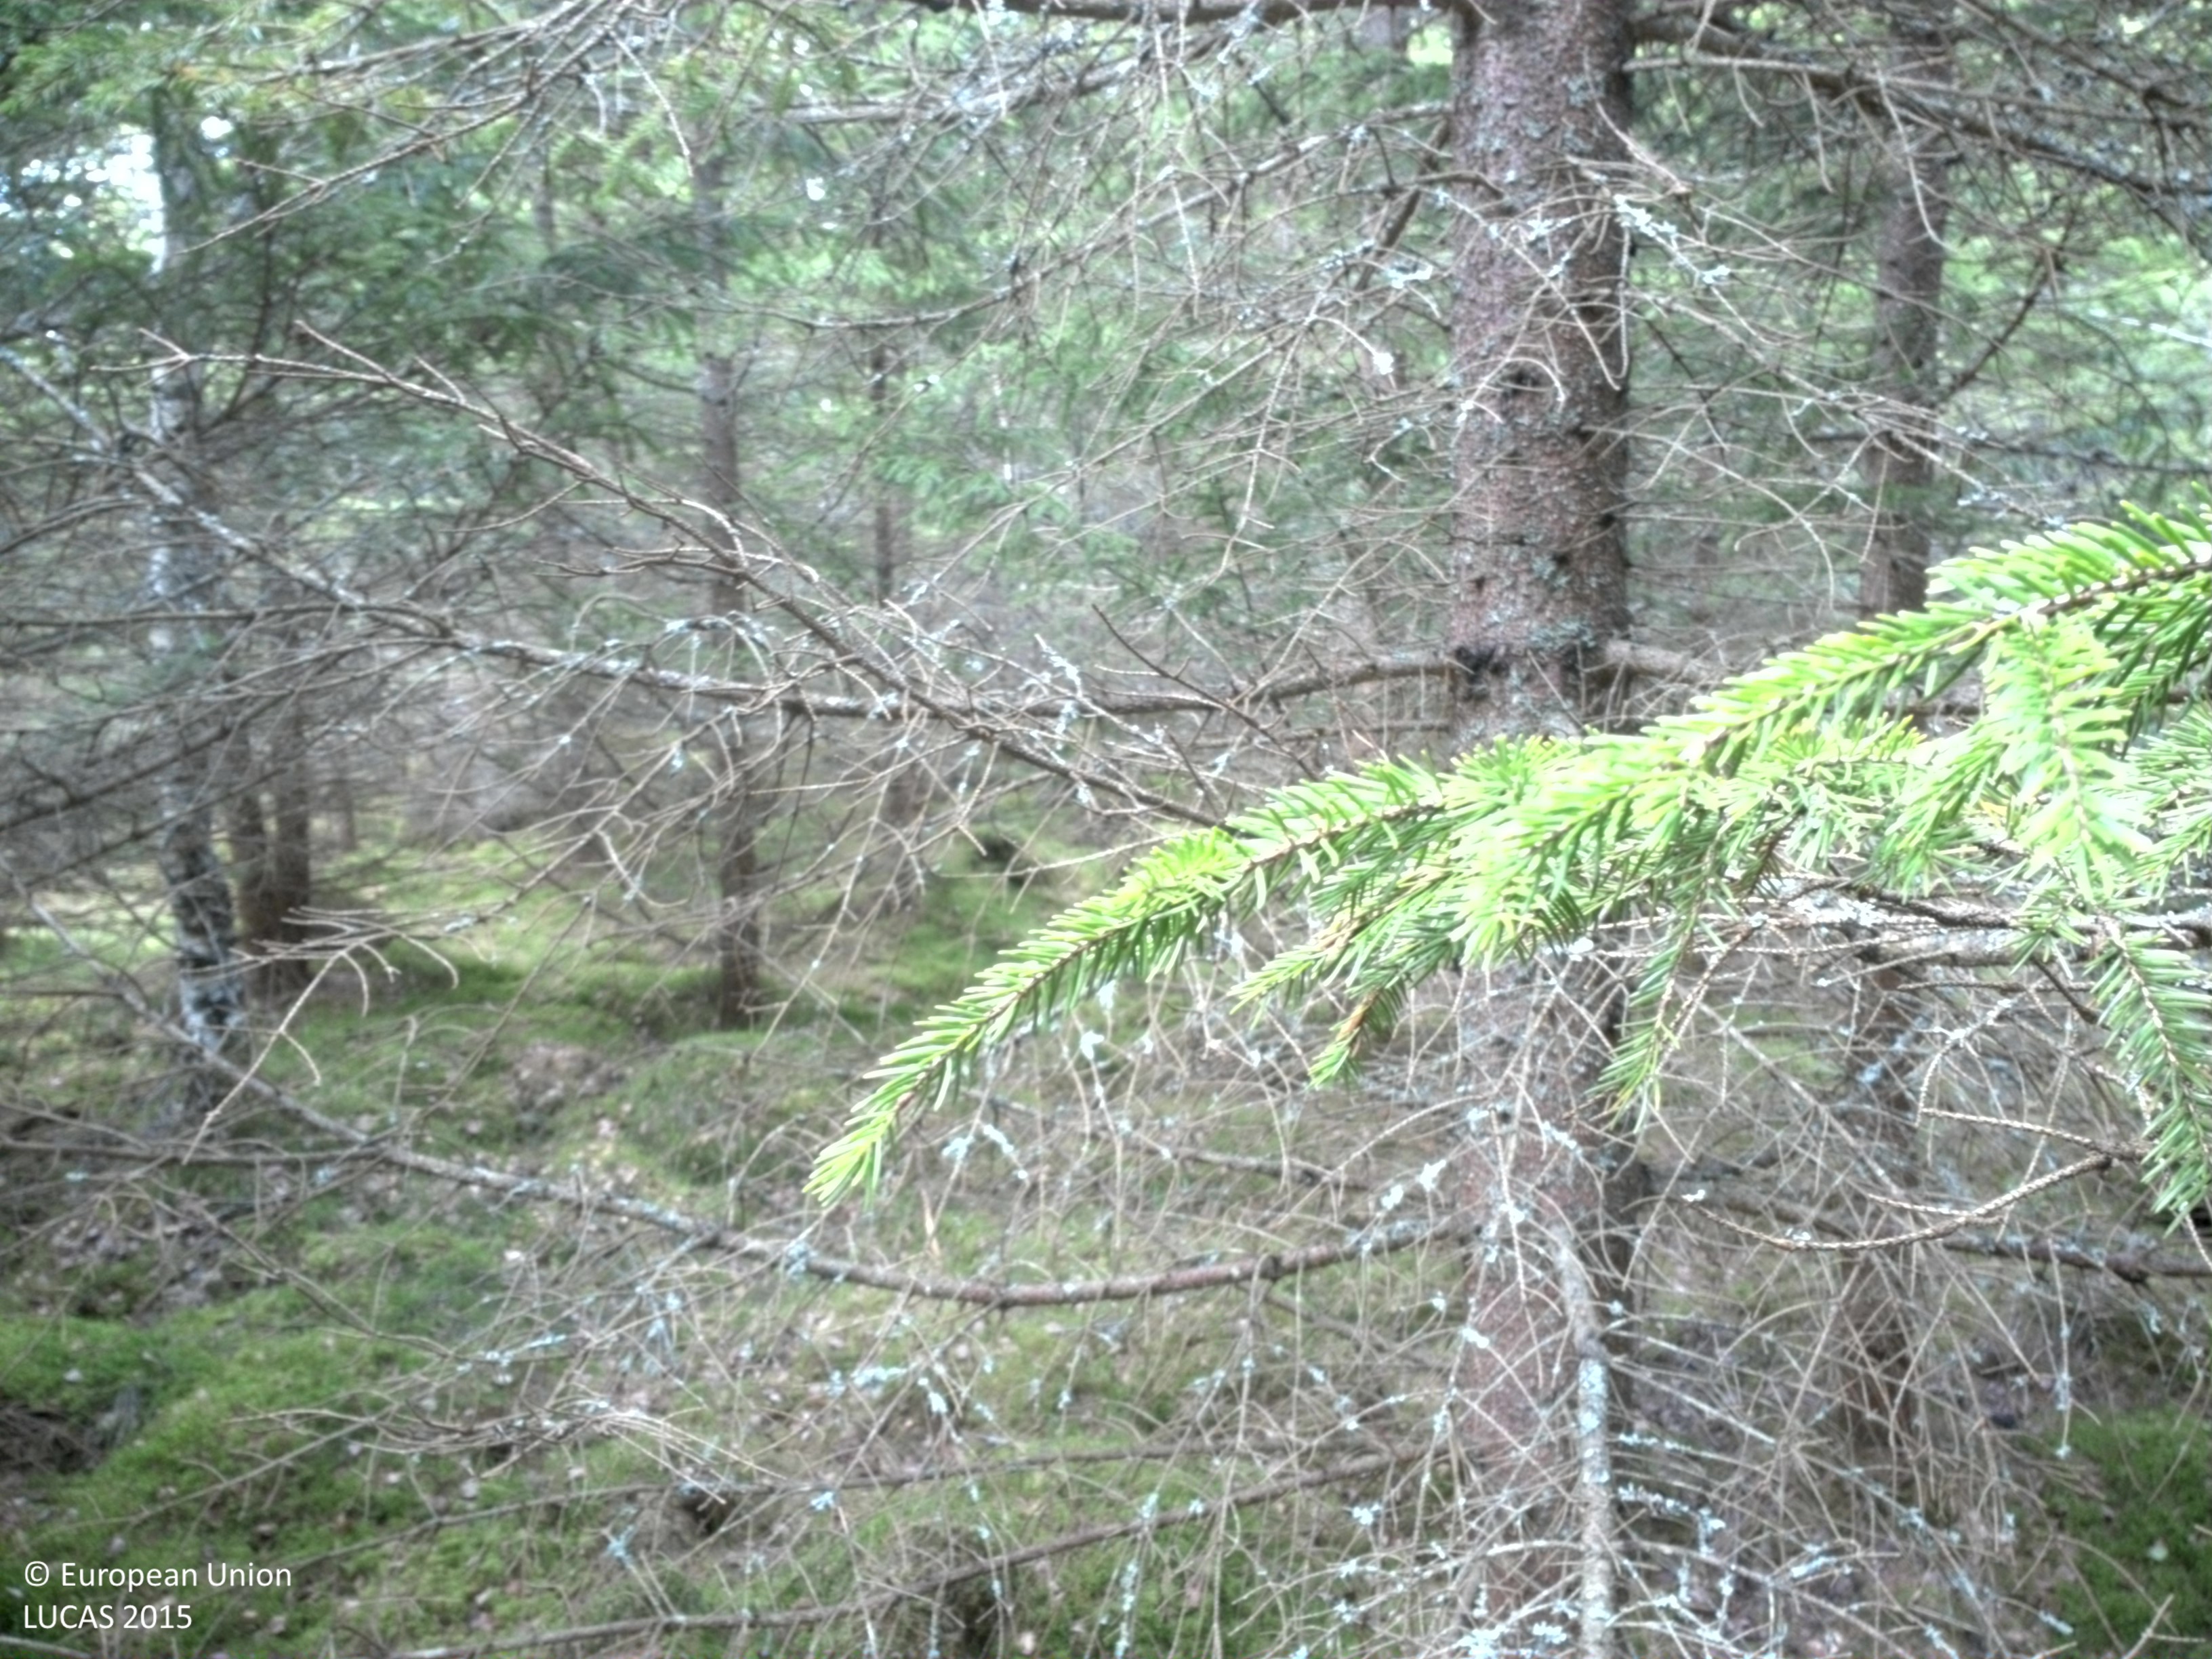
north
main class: Woodland
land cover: Spruce dominated coniferous woodland
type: boreal forest
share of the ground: > 75 %
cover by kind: coniferous forest trees 85 %, lichens and mosses 10 %, broadleaved forest trees 5 %
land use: Forestry
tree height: > 5 m
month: May
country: SE
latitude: 56.6961
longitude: 15.1745
